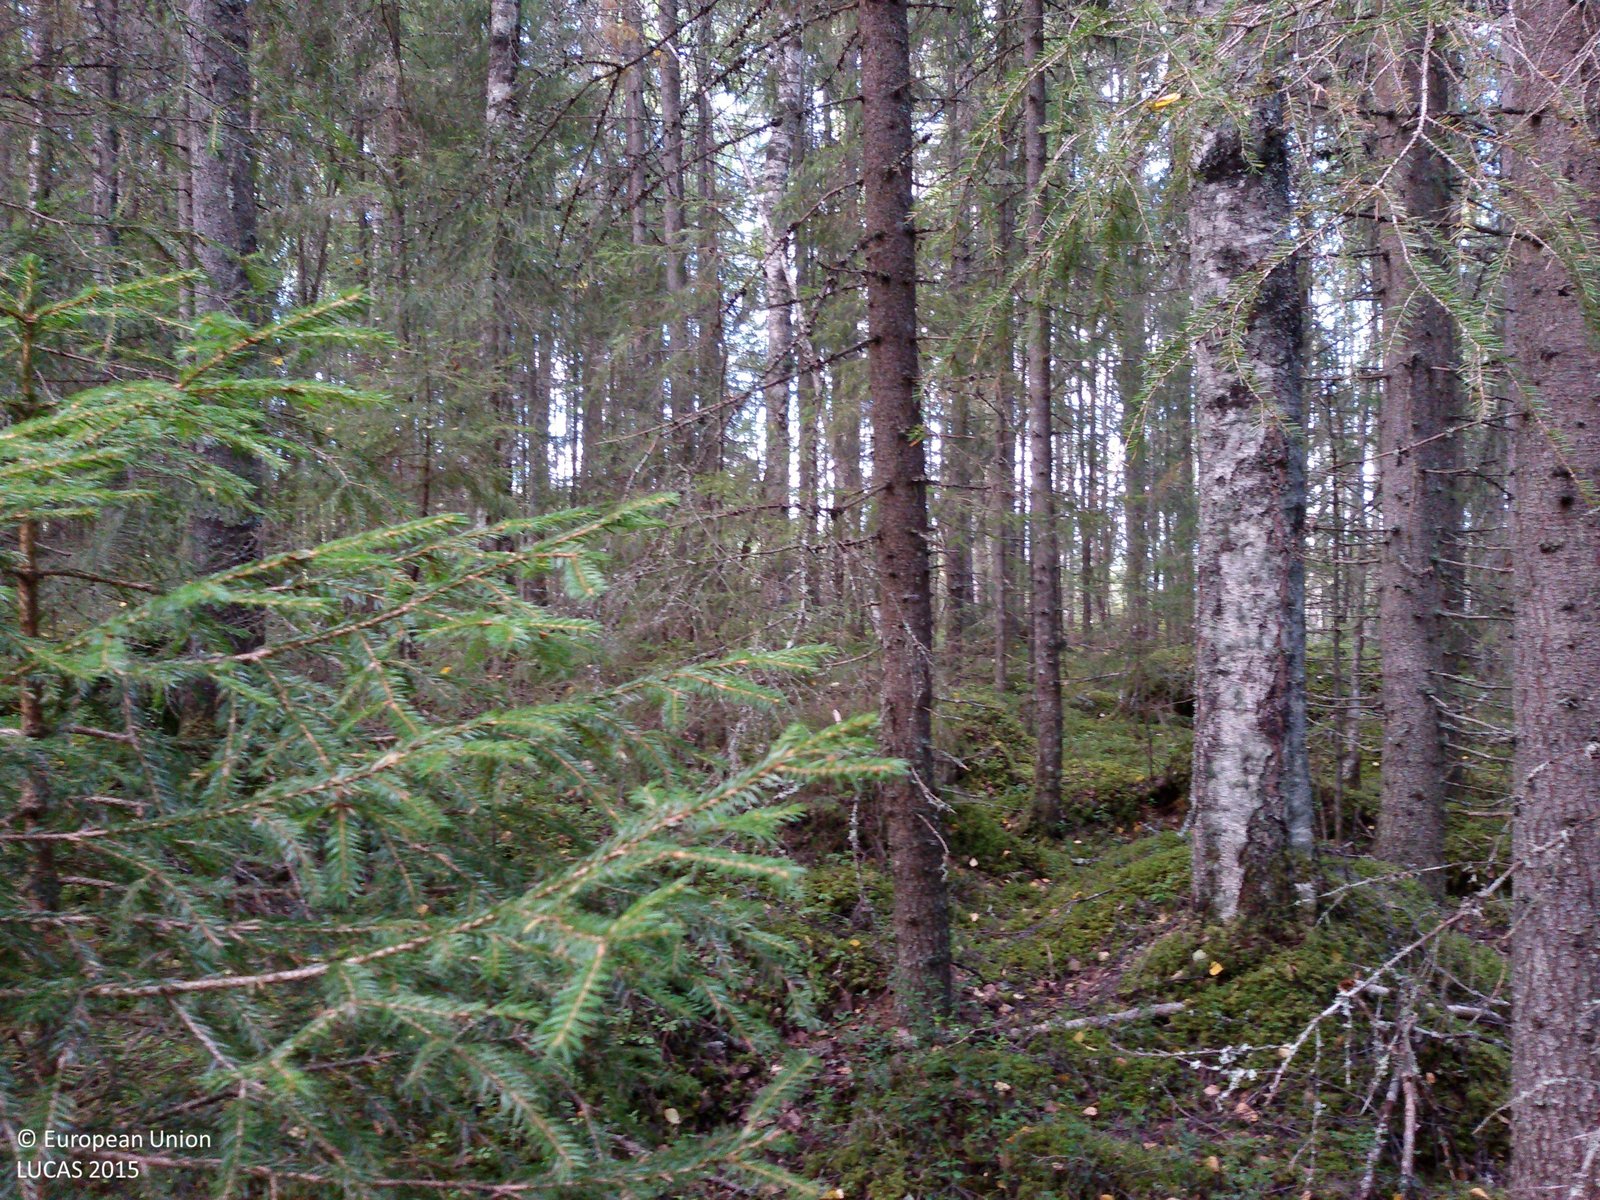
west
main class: Woodland
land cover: Spruce dominated coniferous woodland
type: boreal forest
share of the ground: > 75 %
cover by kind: coniferous forest trees 90 %, lichens and mosses 10 %
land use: Forestry
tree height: > 5 m
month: September
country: SE
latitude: 60.9454
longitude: 15.3577
